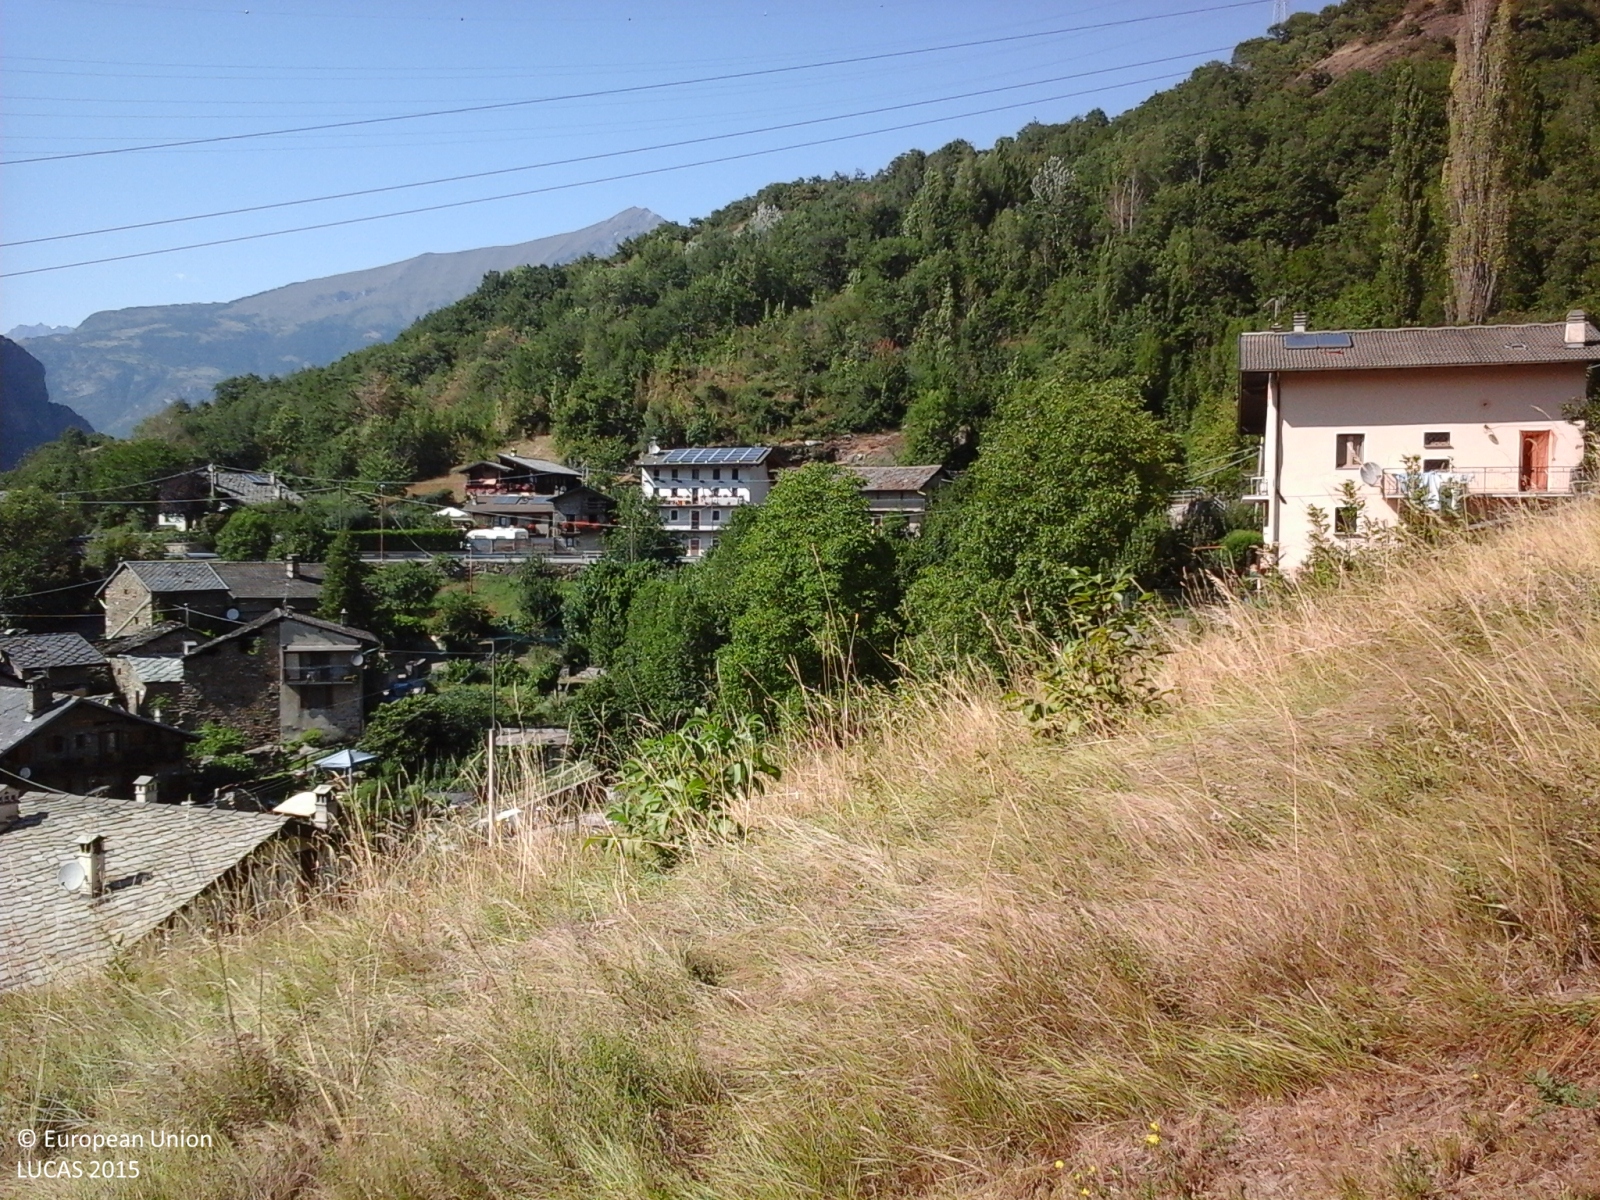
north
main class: Grassland
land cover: Grassland with sparse tree/shrub cover
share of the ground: > 75 %
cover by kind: herbaceous plants 95 %, broadleaved forest trees 5 %
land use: Agriculture (excluding fallow land and kitchen gardens)
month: July
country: IT
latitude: 45.6952
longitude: 7.6789
